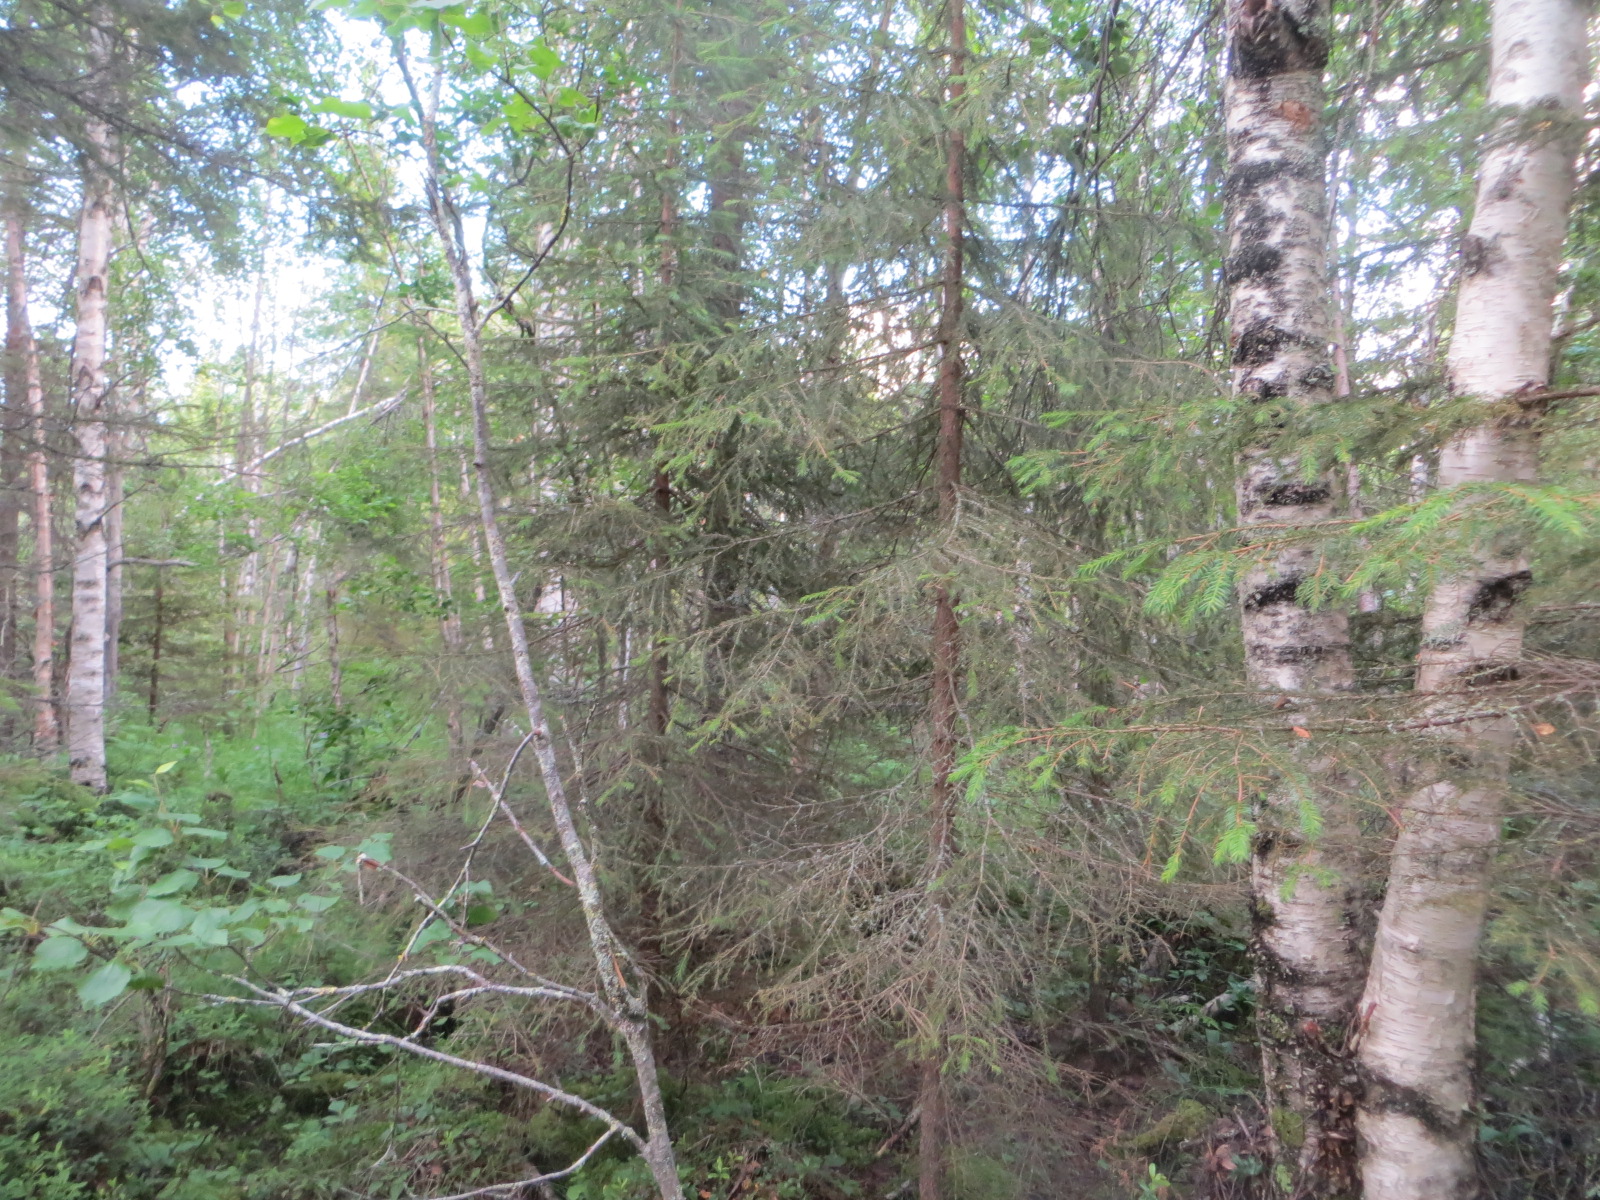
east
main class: Woodland
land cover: Other mixed woodland
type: boreal forest
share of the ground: 50 - 75 %
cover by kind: coniferous forest trees 40 %, broadleaved forest trees 30 %, shrubs 20 %, herbaceous plants 10 %
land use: Forestry
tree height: > 5 m
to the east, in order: Other mixed woodland; Ditches and canals; Other mixed woodland; Spruce dominated mixed woodland; Ditches and canals; Spruce dominated mixed woodland; Ditches and canals; Temporary grasslands; Ditches and canals; Temporary grasslands
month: July
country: FI
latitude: 66.3127
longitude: 24.4791
